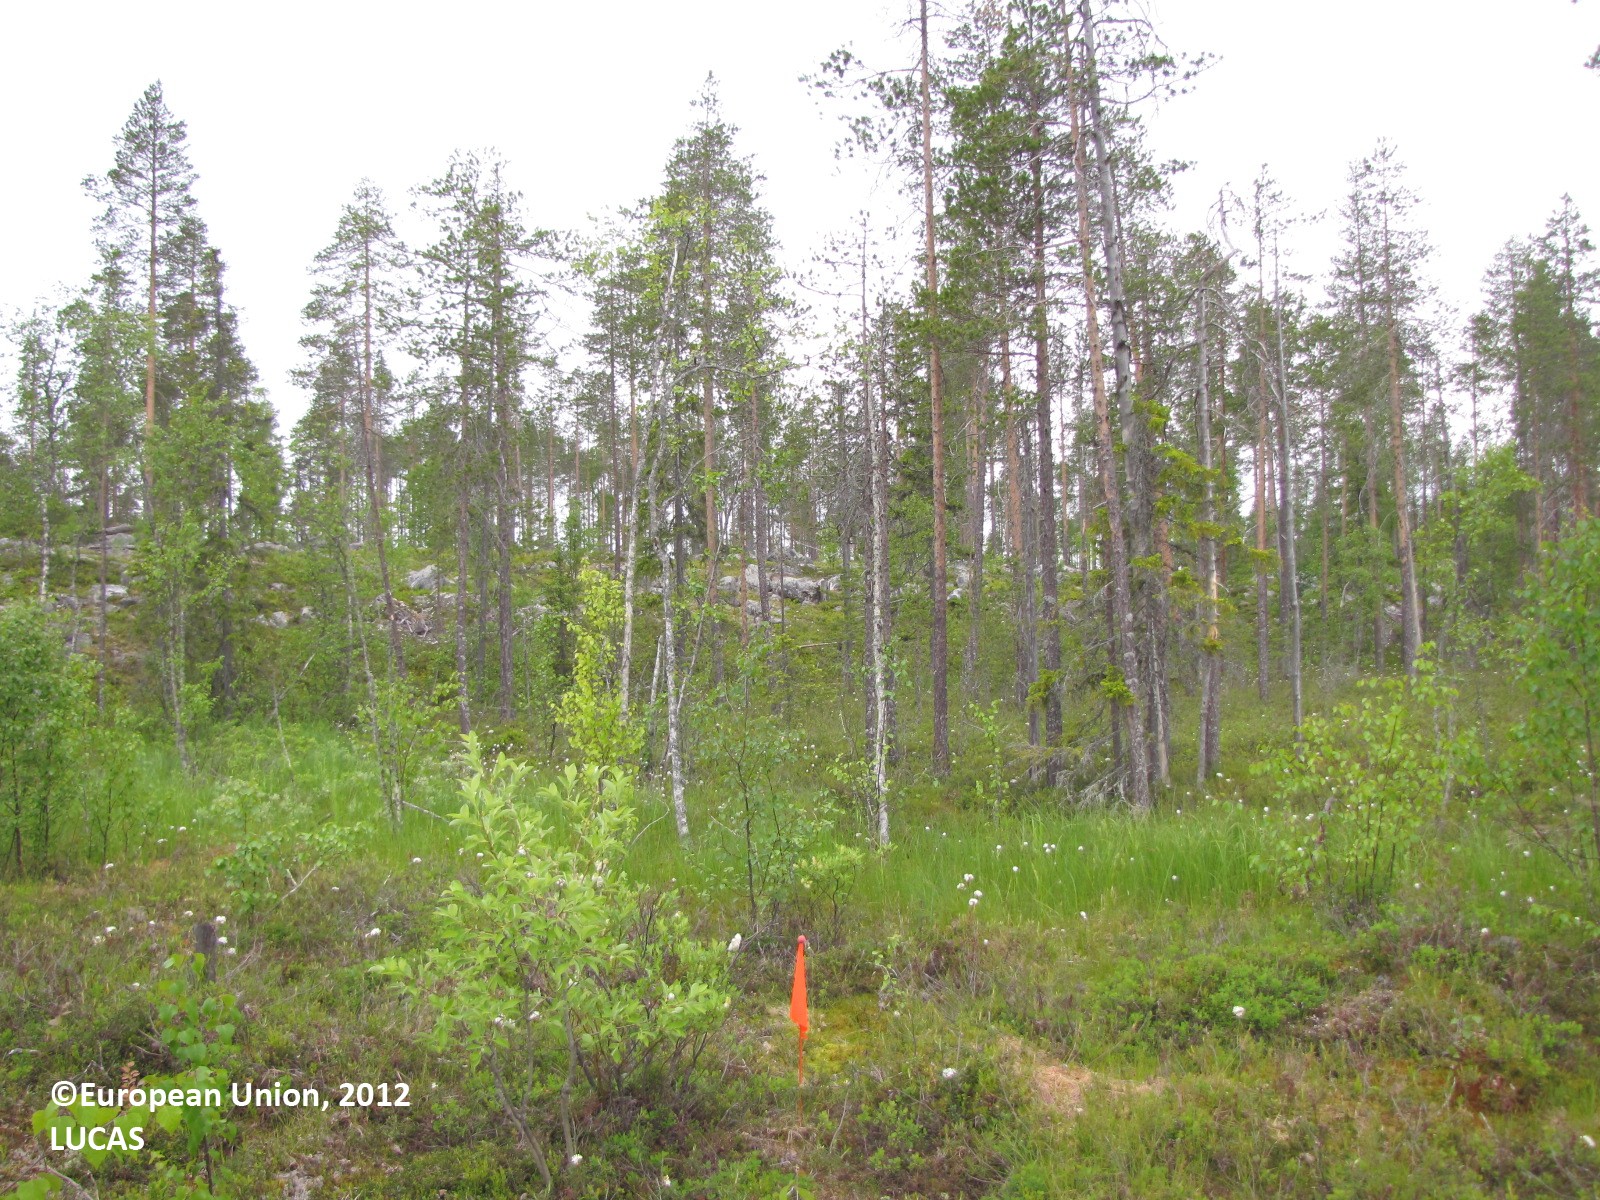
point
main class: Woodland
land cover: Pine dominated mixed woodland
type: boreal forest
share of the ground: 10 - 25 %
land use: Forestry
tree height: > 5 m
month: June
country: FI
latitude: 66.1477
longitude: 24.8823
